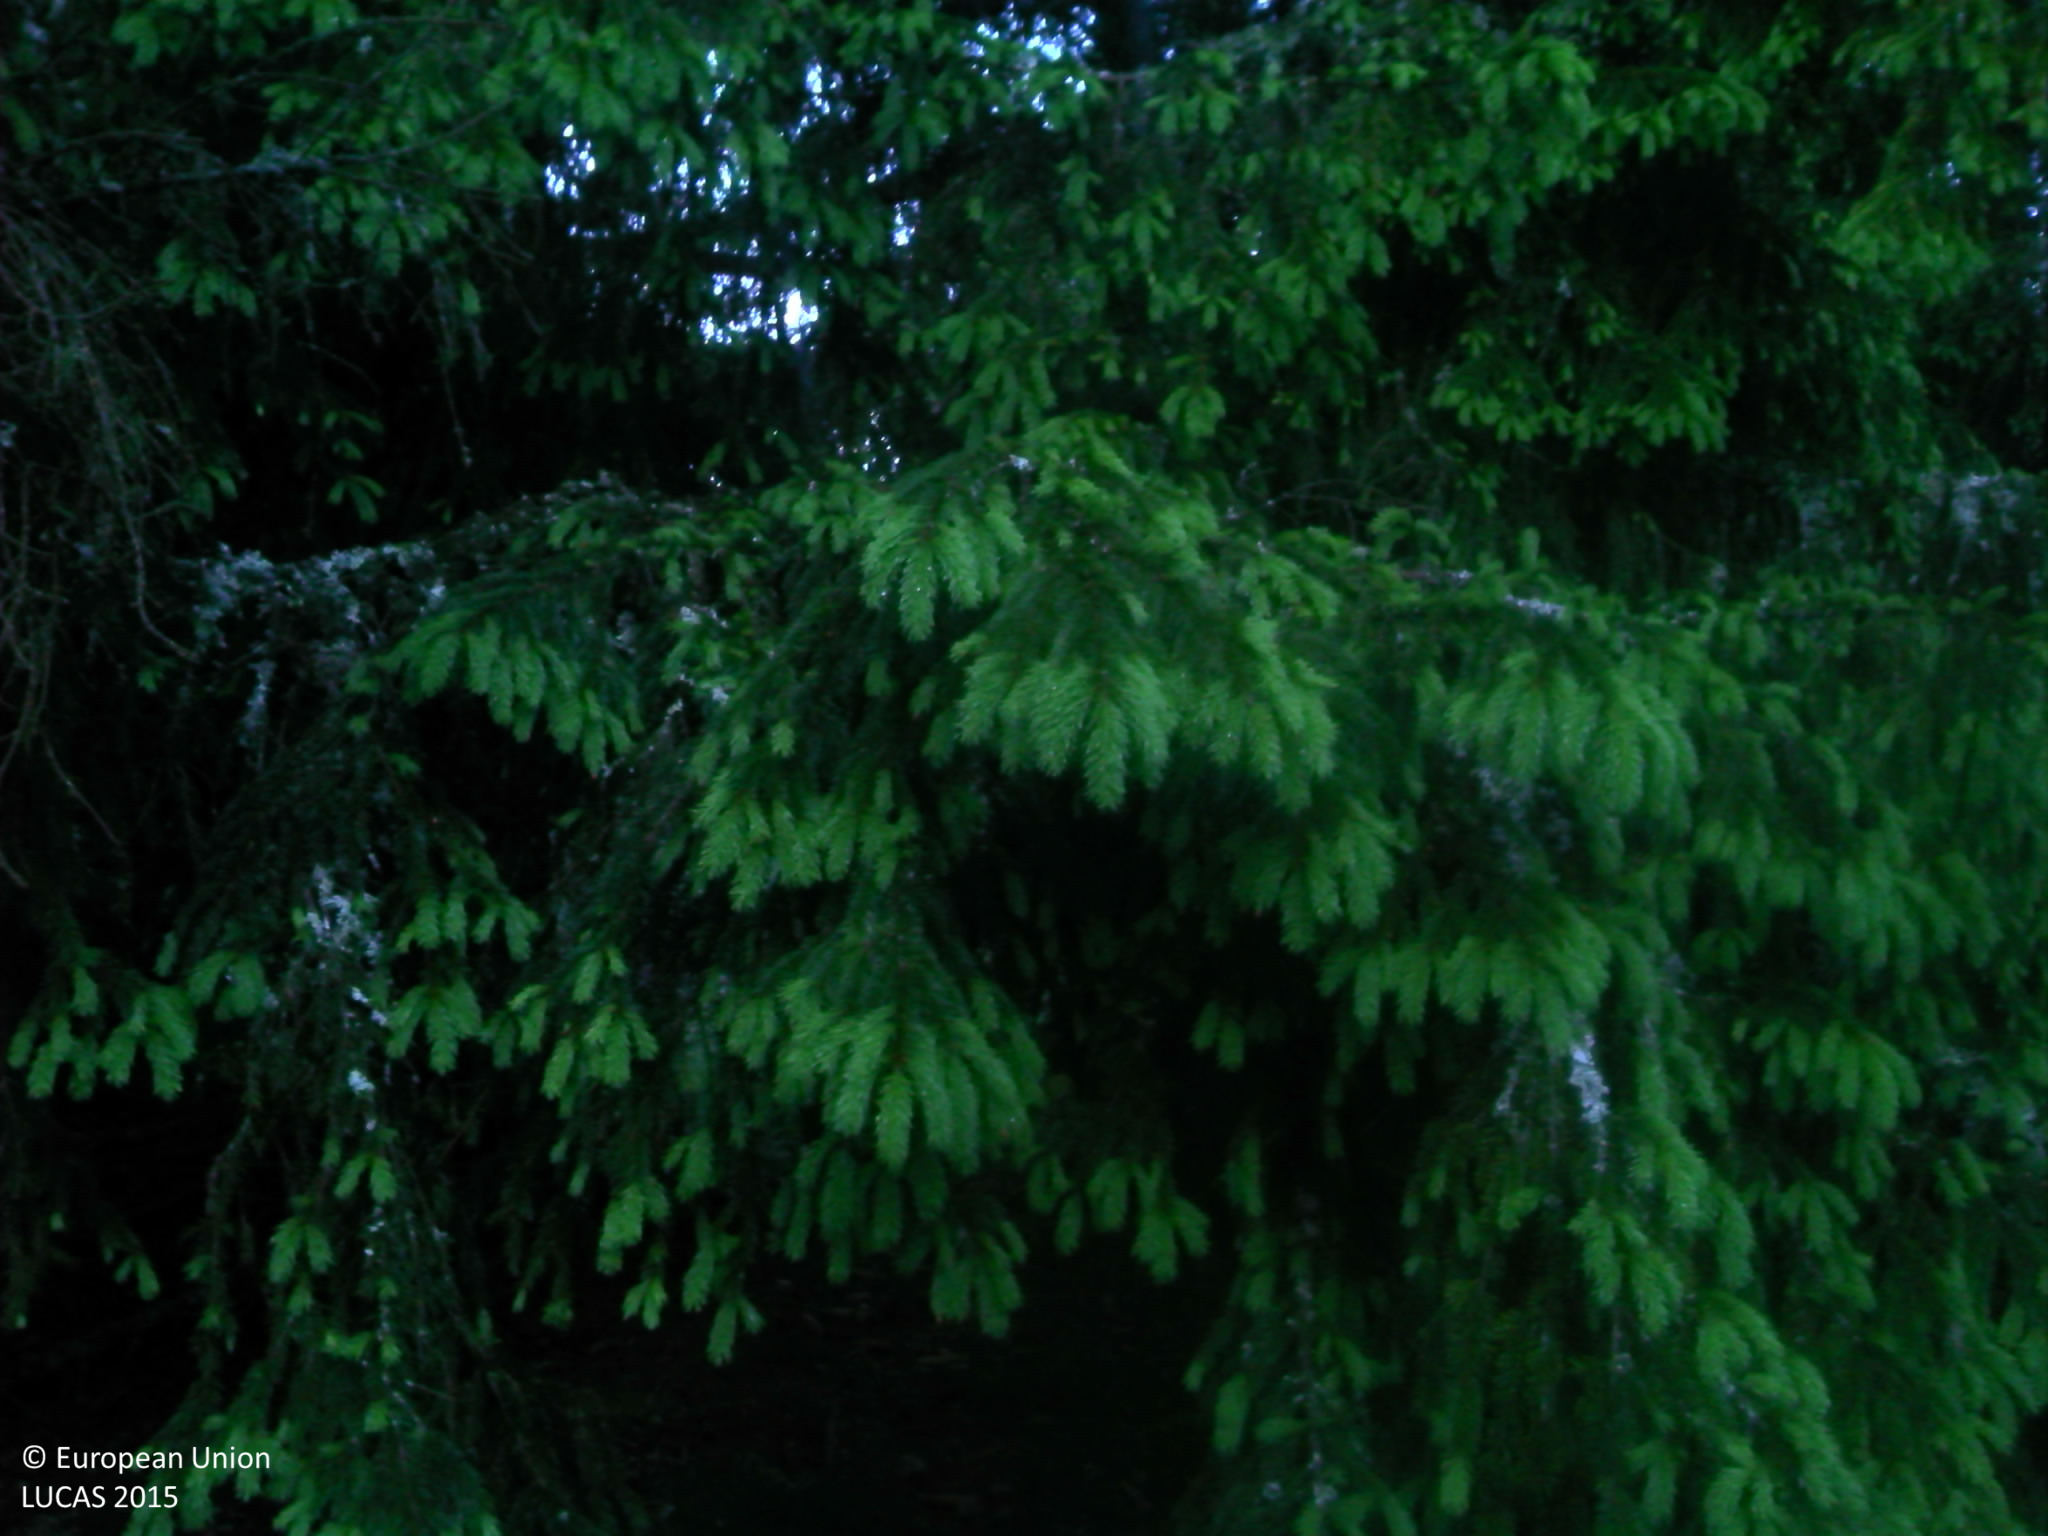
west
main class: Woodland
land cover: Spruce dominated coniferous woodland
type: alpine coniferous forest
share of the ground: > 75 %
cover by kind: coniferous forest trees 50 %, herbaceous plants 40 %, shrubs 5 %, lichens and mosses 5 %
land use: Forestry
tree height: > 5 m
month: June
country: FR
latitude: 45.1919
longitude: 2.8859
